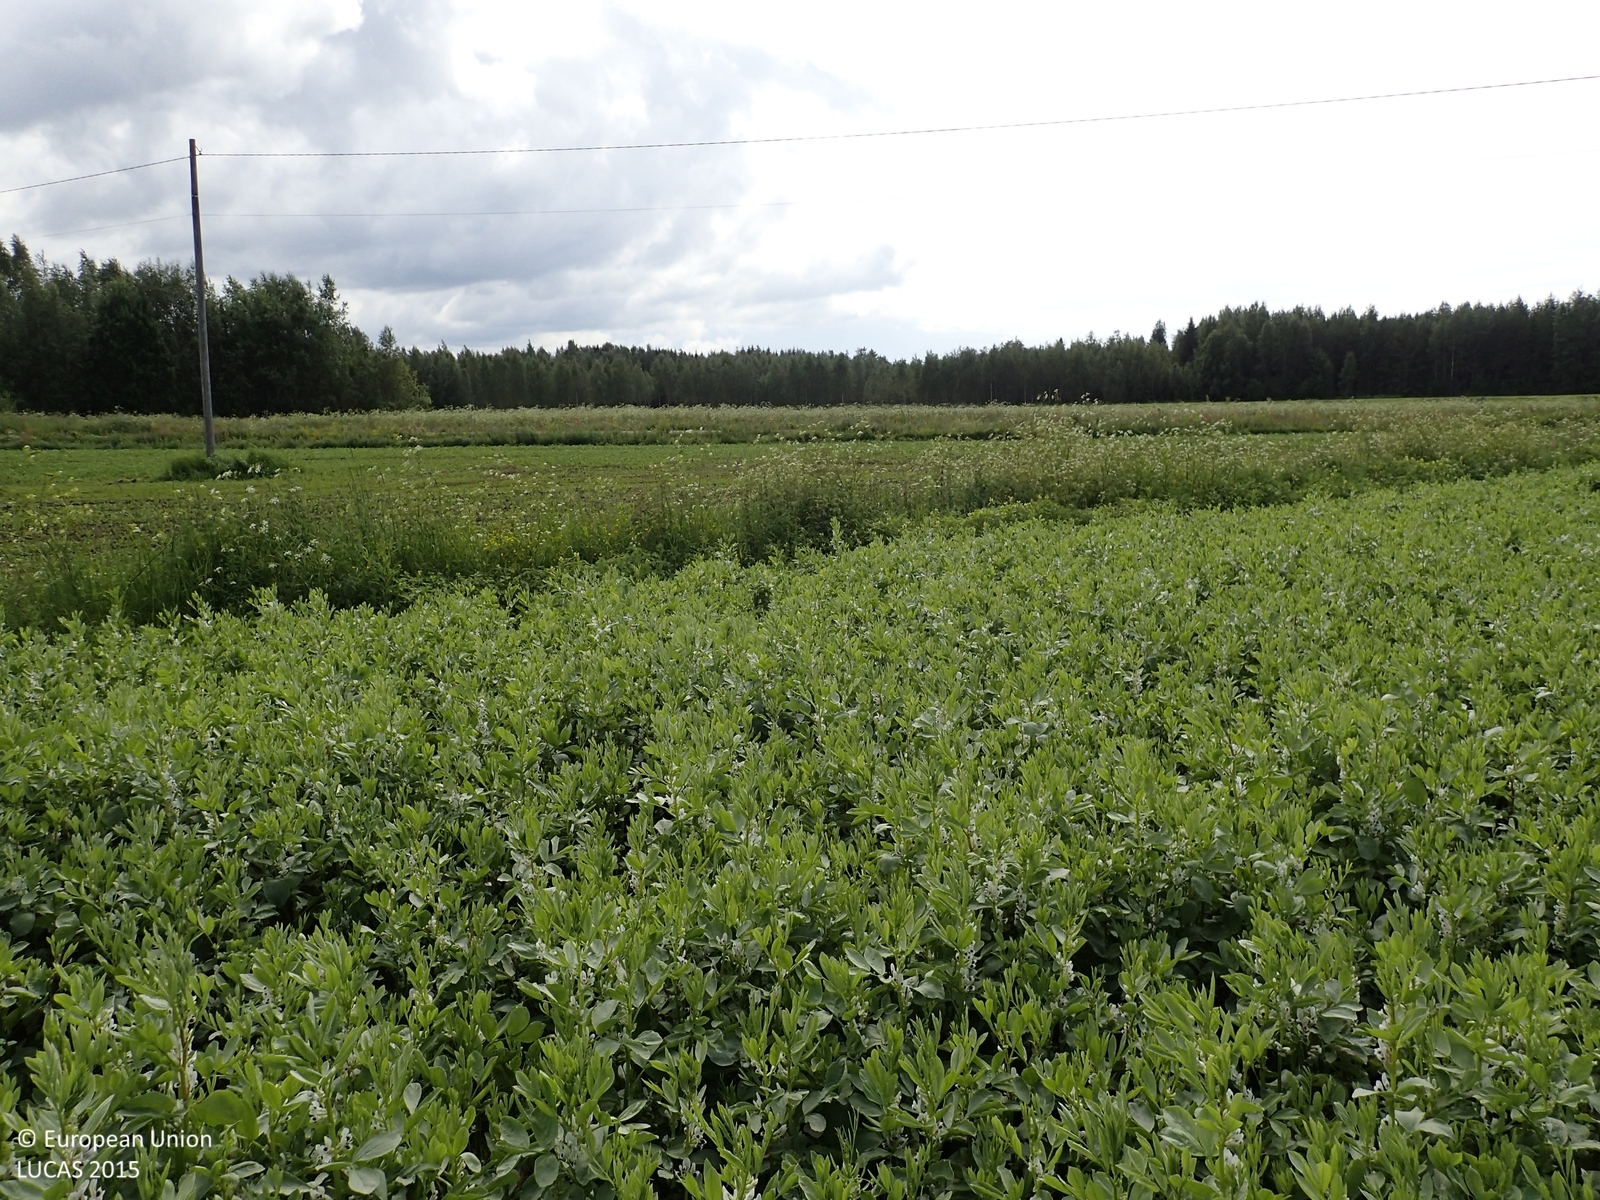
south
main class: Cropland
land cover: Dry pulses
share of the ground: > 75 %
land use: Agriculture (excluding fallow land and kitchen gardens)
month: July
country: FI
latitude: 62.9382
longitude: 21.4868
